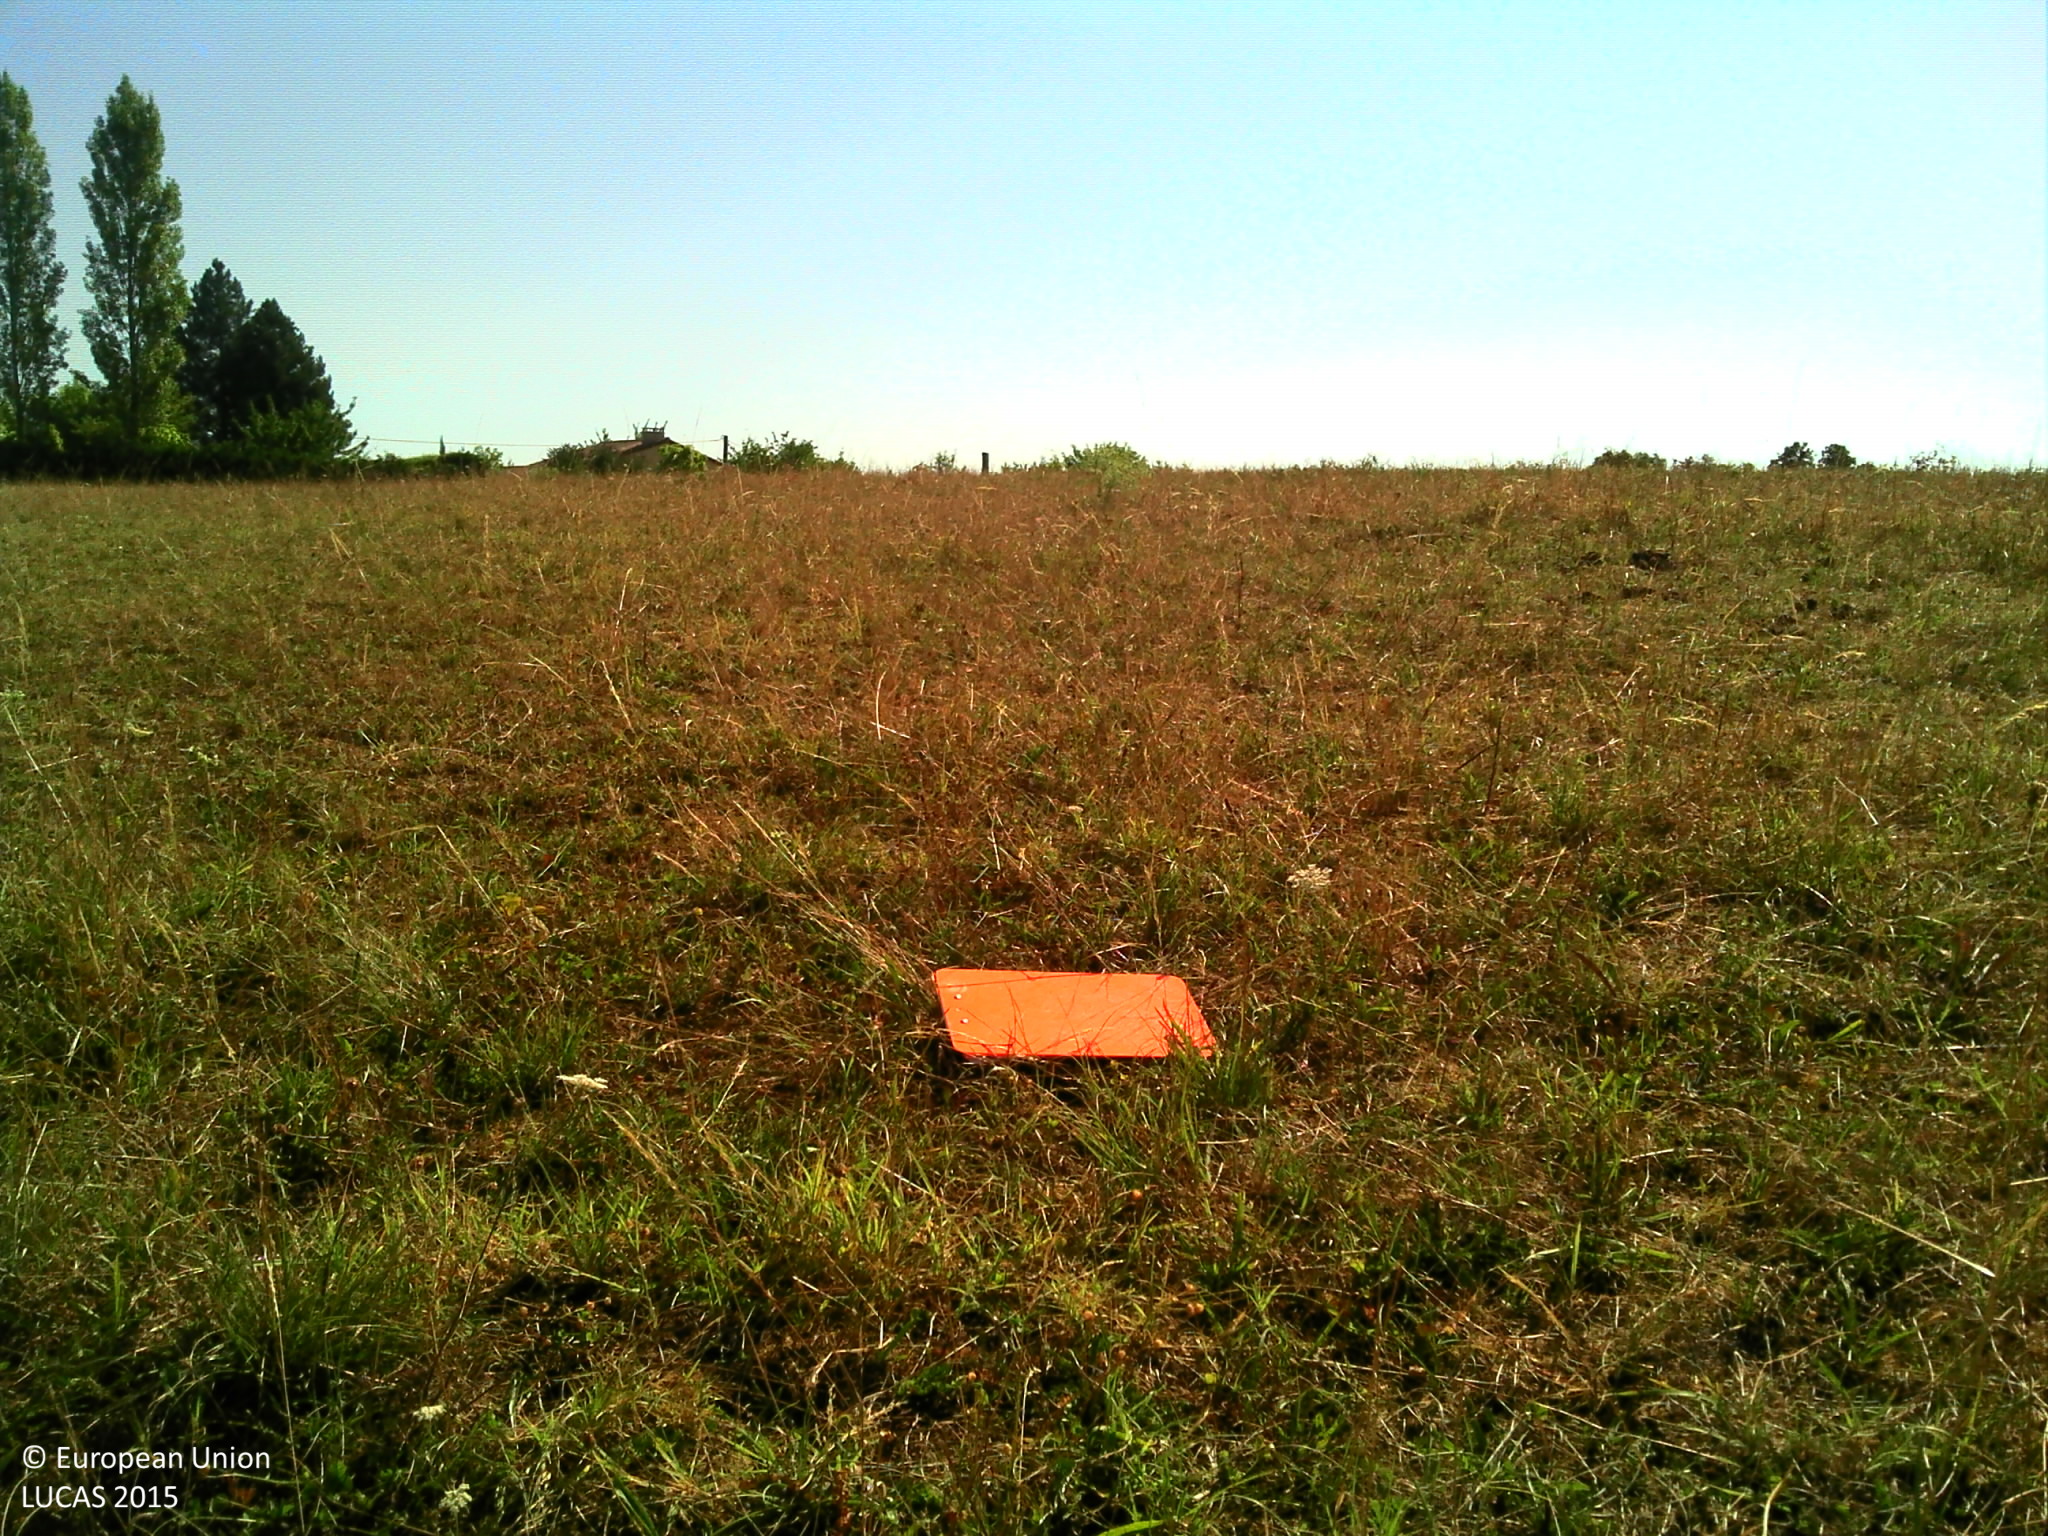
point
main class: Grassland
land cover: Grassland without tree/shrub cover
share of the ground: > 75 %
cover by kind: herbaceous plants 100 %
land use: Agriculture (excluding fallow land and kitchen gardens)
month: July
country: FR
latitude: 44.6487
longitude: 0.5983
